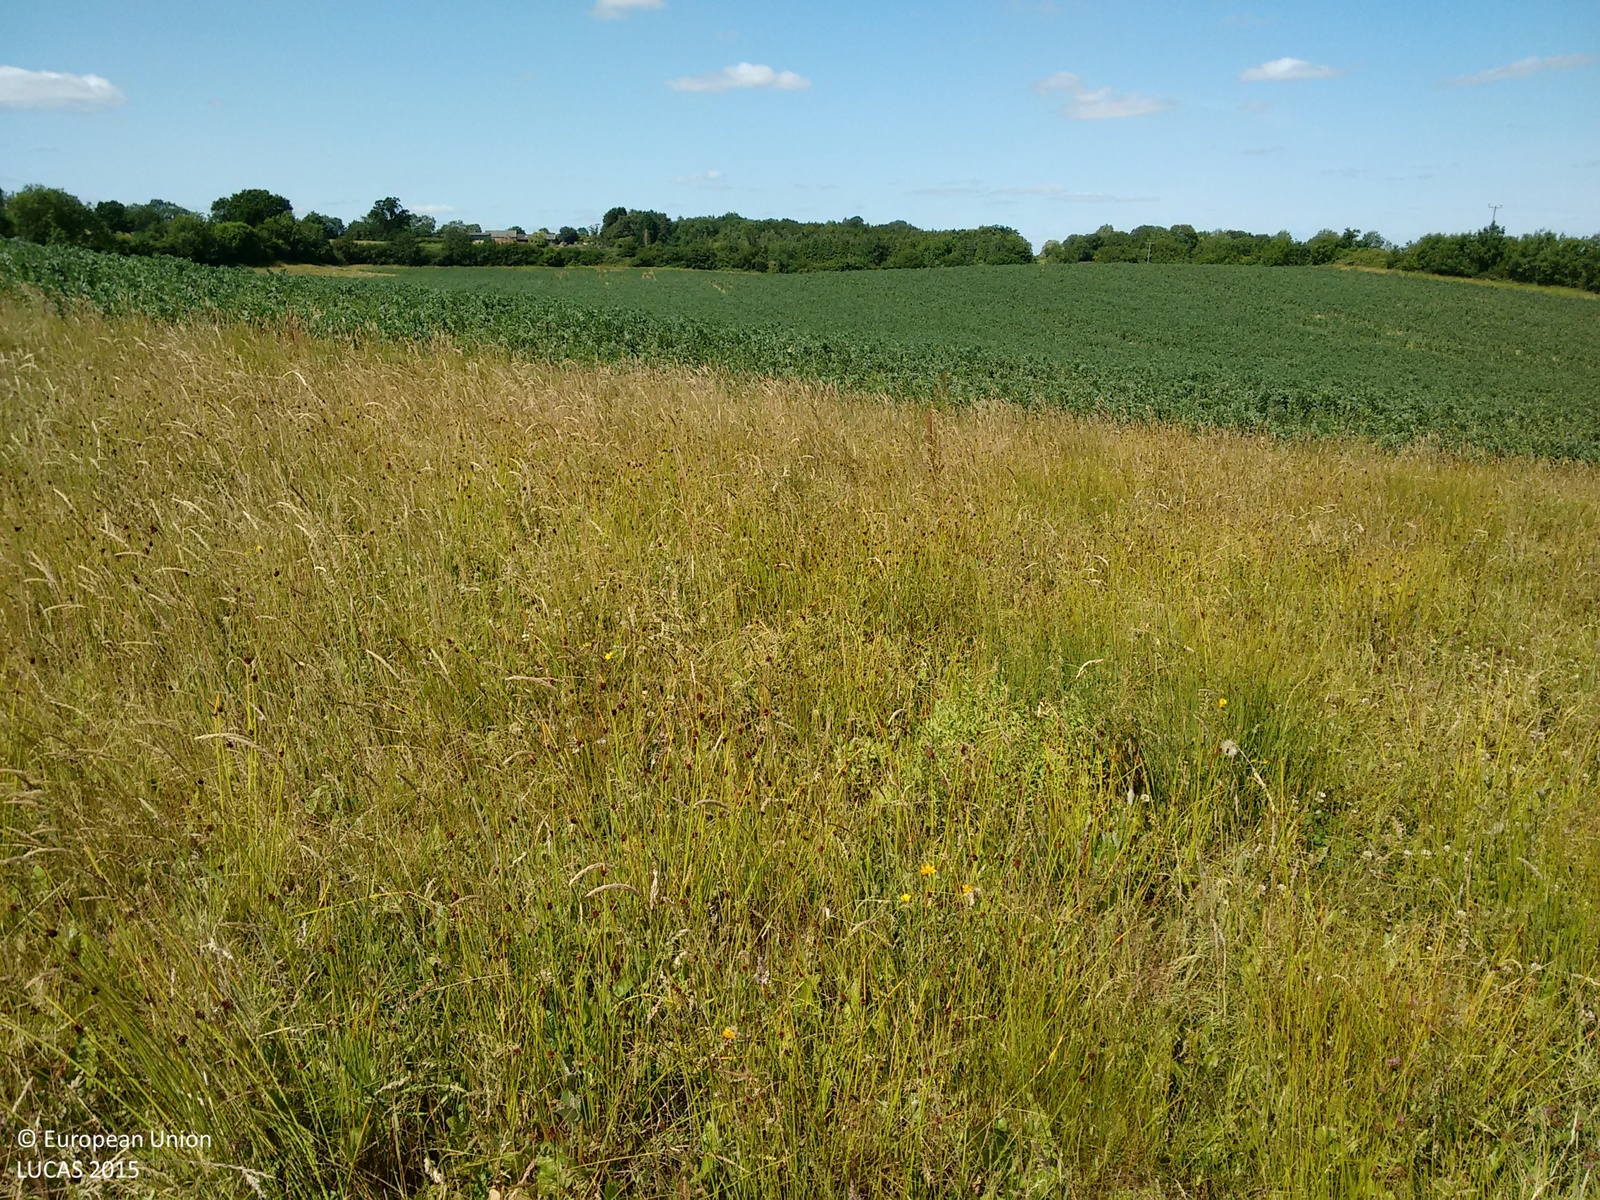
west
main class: Grassland
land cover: Grassland without tree/shrub cover
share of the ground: > 75 %
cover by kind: herbaceous plants 100 %
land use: Agriculture (excluding fallow land and kitchen gardens)
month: July
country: GB
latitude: 51.9576
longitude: -1.3561
